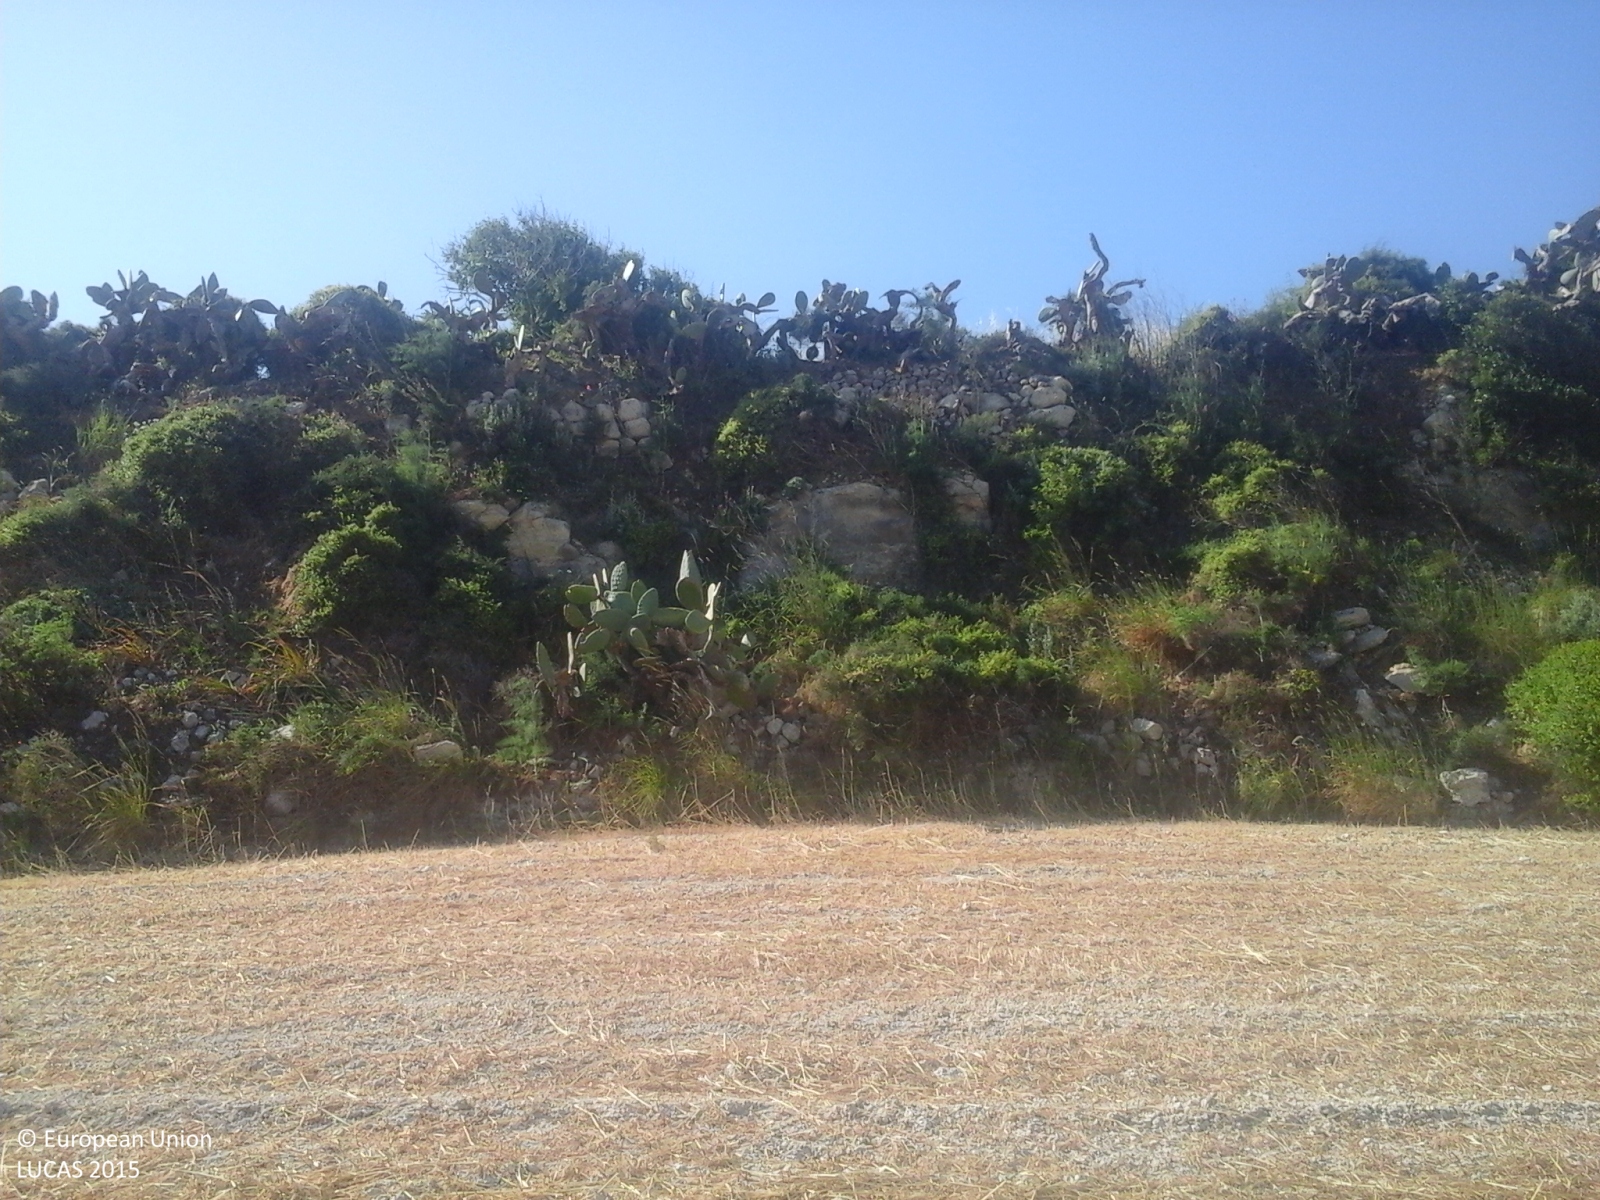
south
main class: Cropland
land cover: Mixed cereals for fodder
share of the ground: > 75 %
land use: Agriculture (excluding fallow land and kitchen gardens)
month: May
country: MT
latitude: 35.8987
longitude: 14.4021
